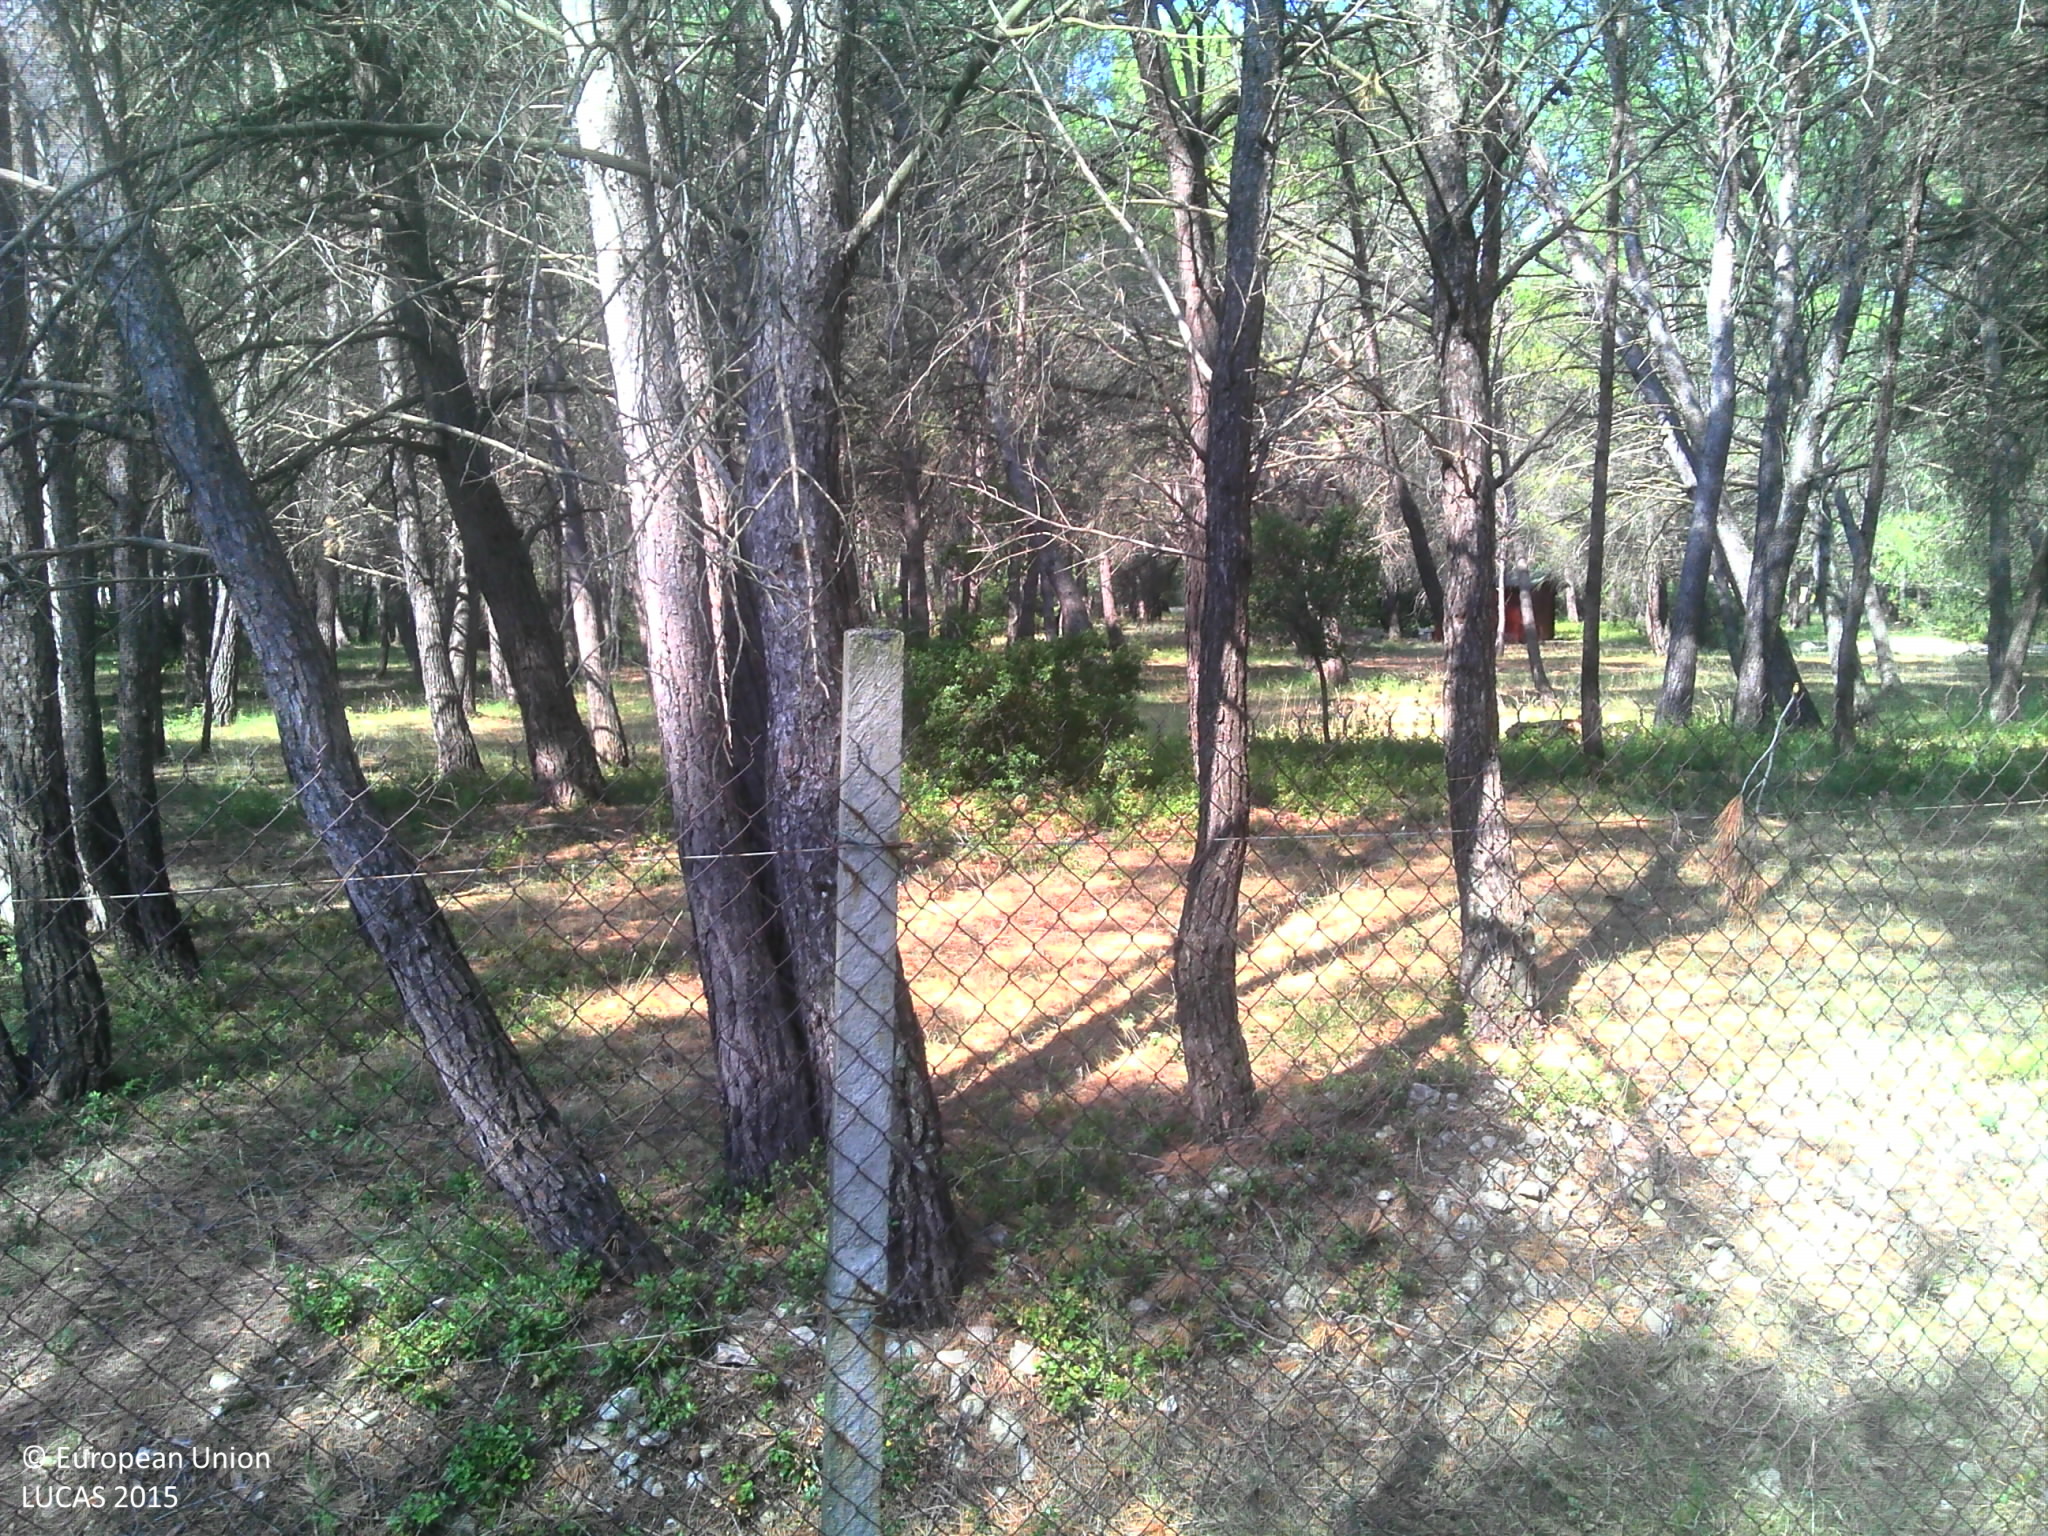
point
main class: Woodland
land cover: Pine dominated coniferous woodland
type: coniferous forest of the mediterranean region
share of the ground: > 75 %
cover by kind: coniferous forest trees 60 %, herbaceous plants 20 %, shrubs 15 %, broadleaved forest trees 5 %
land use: Residential
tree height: > 5 m
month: July
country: FR
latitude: 43.6281
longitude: 5.2627
